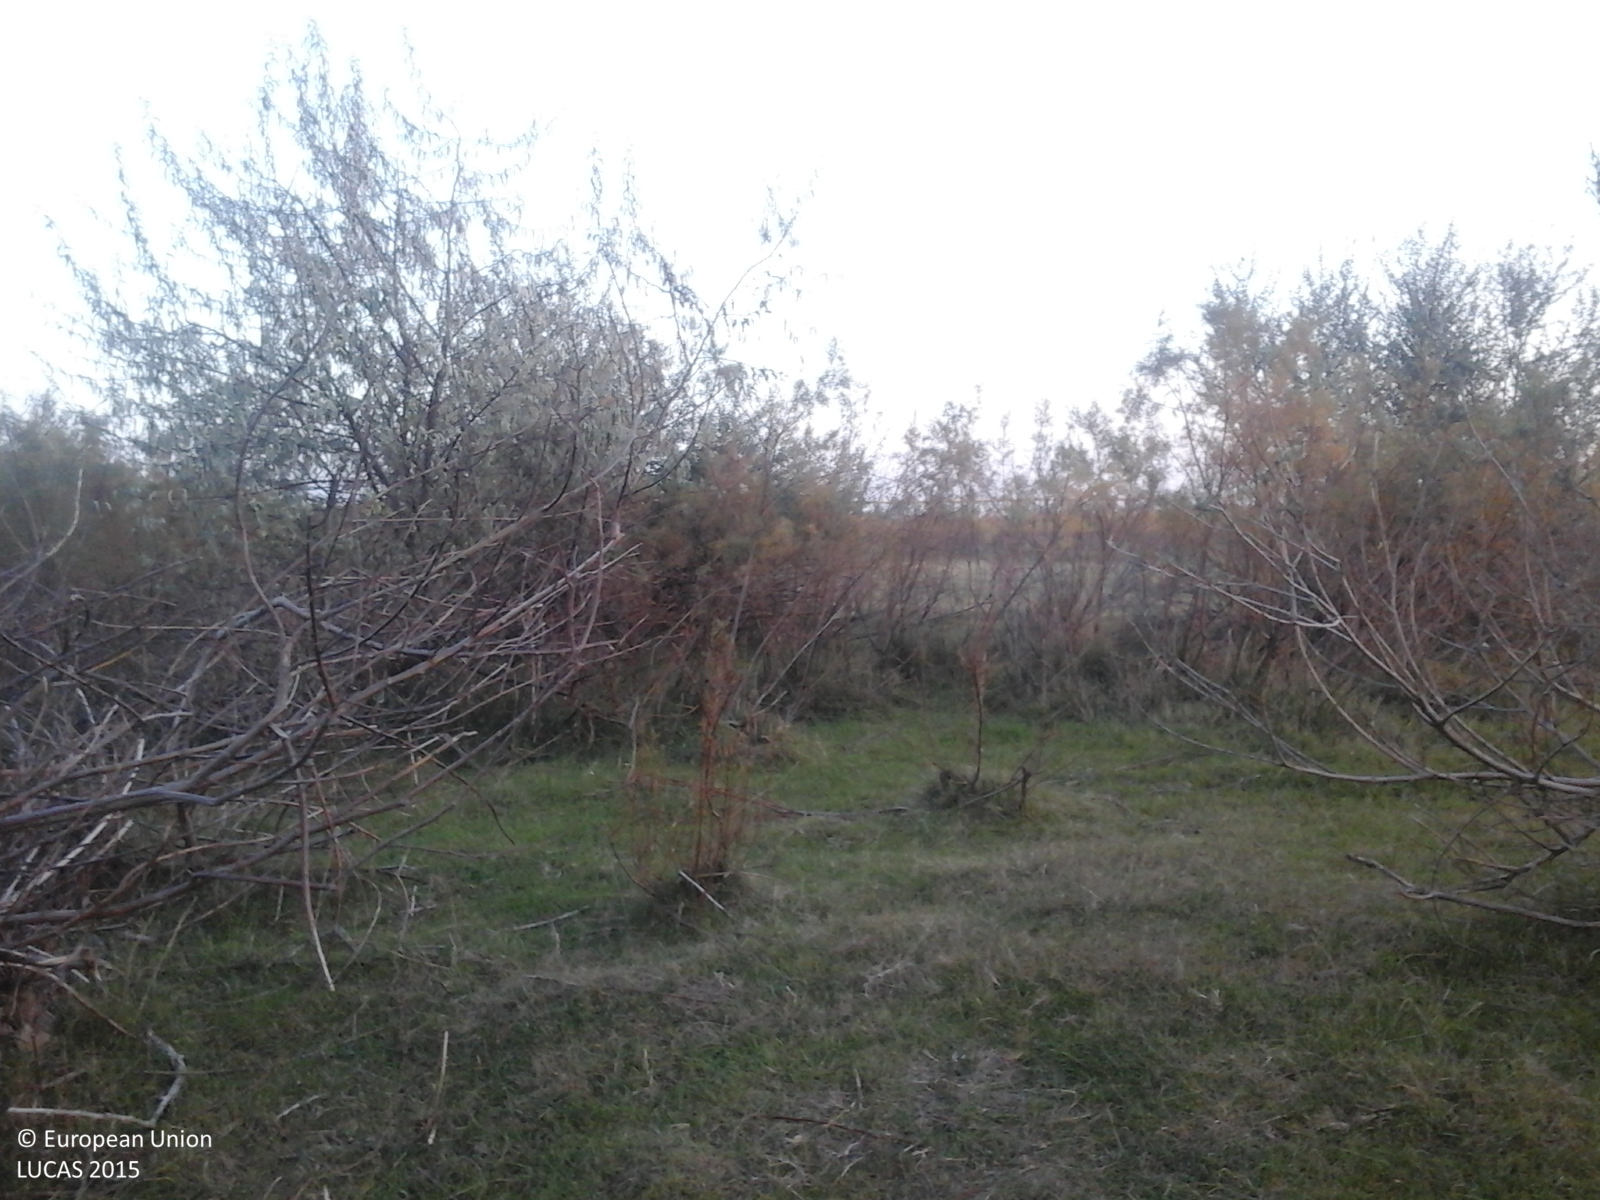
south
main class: Shrubland
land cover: Shrubland without tree cover
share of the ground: > 75 %
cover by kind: shrubs 90 %, herbaceous plants 10 %
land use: Semi-natural and natural areas not in use
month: October
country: RO
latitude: 45.0887
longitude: 26.9951
